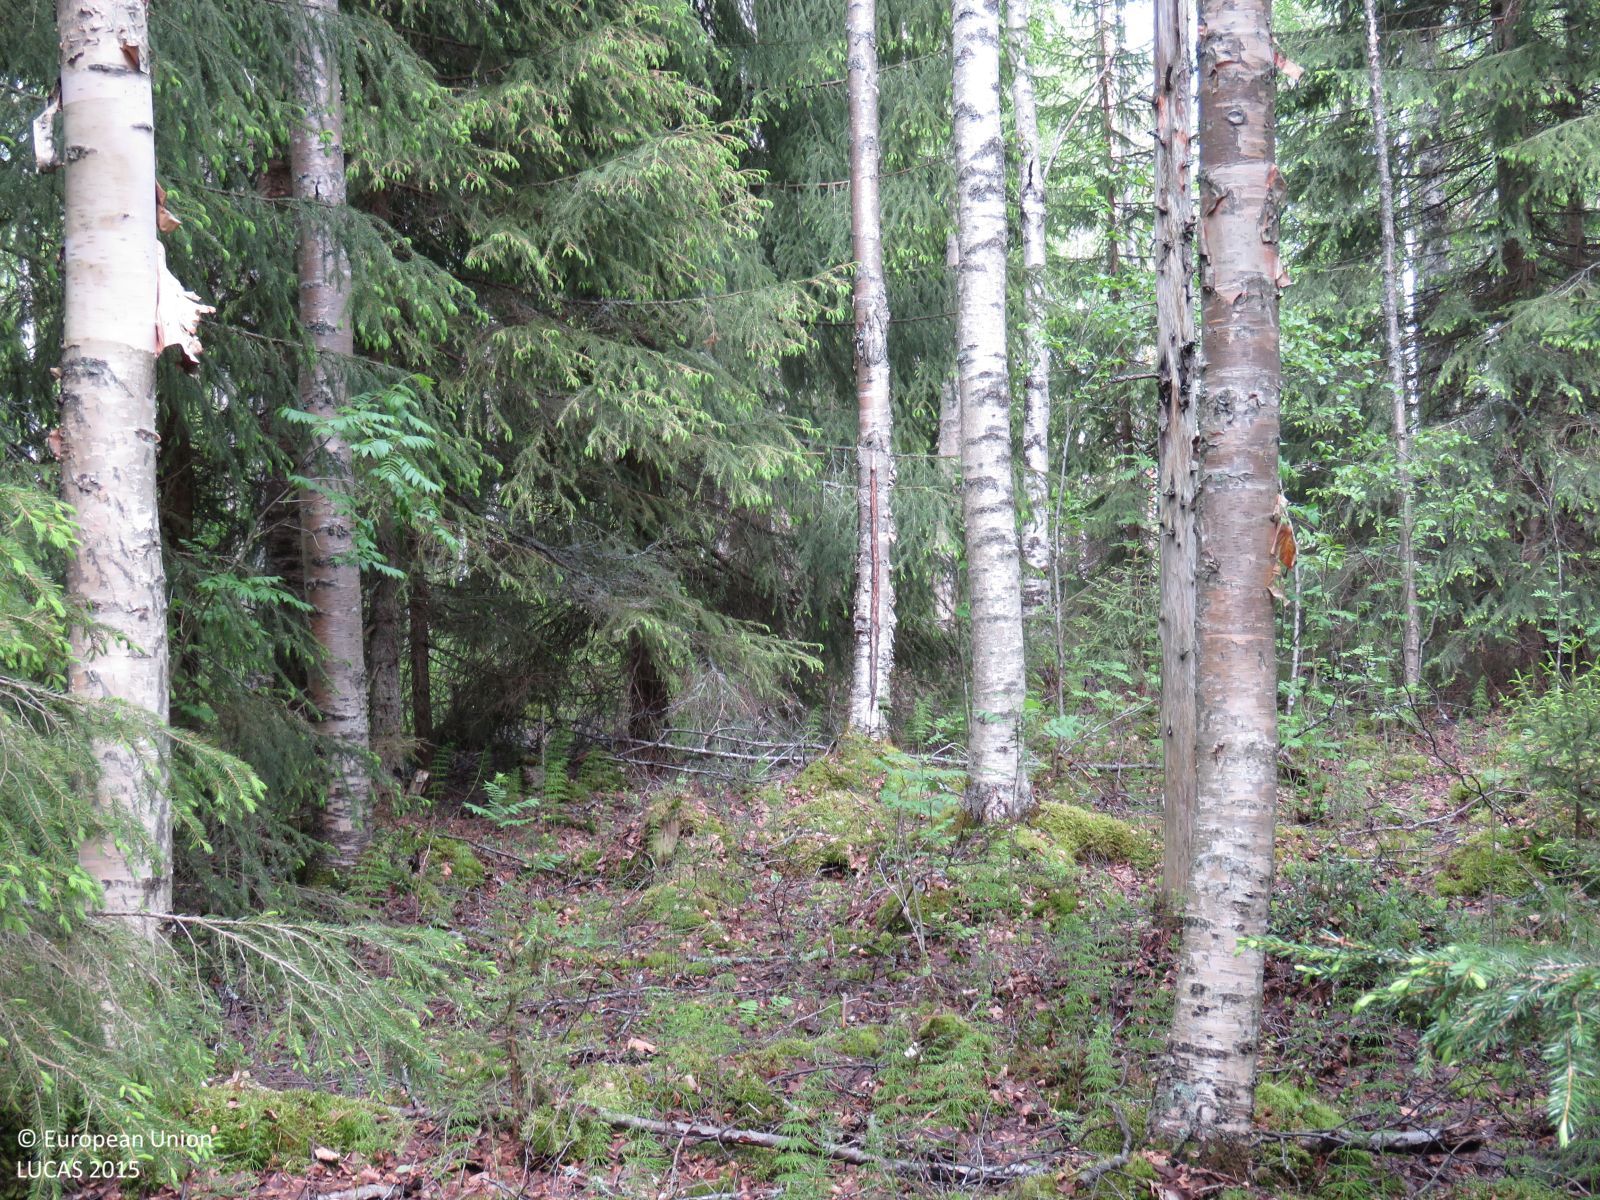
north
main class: Woodland
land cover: Broadleaved woodland
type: non-riverine alder, birch or aspen forest
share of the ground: > 75 %
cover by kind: broadleaved forest trees 65 %, coniferous forest trees 20 %, shrubs 10 %, herbaceous plants 5 %
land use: Forestry
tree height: > 5 m
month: June
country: FI
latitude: 65.0670
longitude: 25.9316
